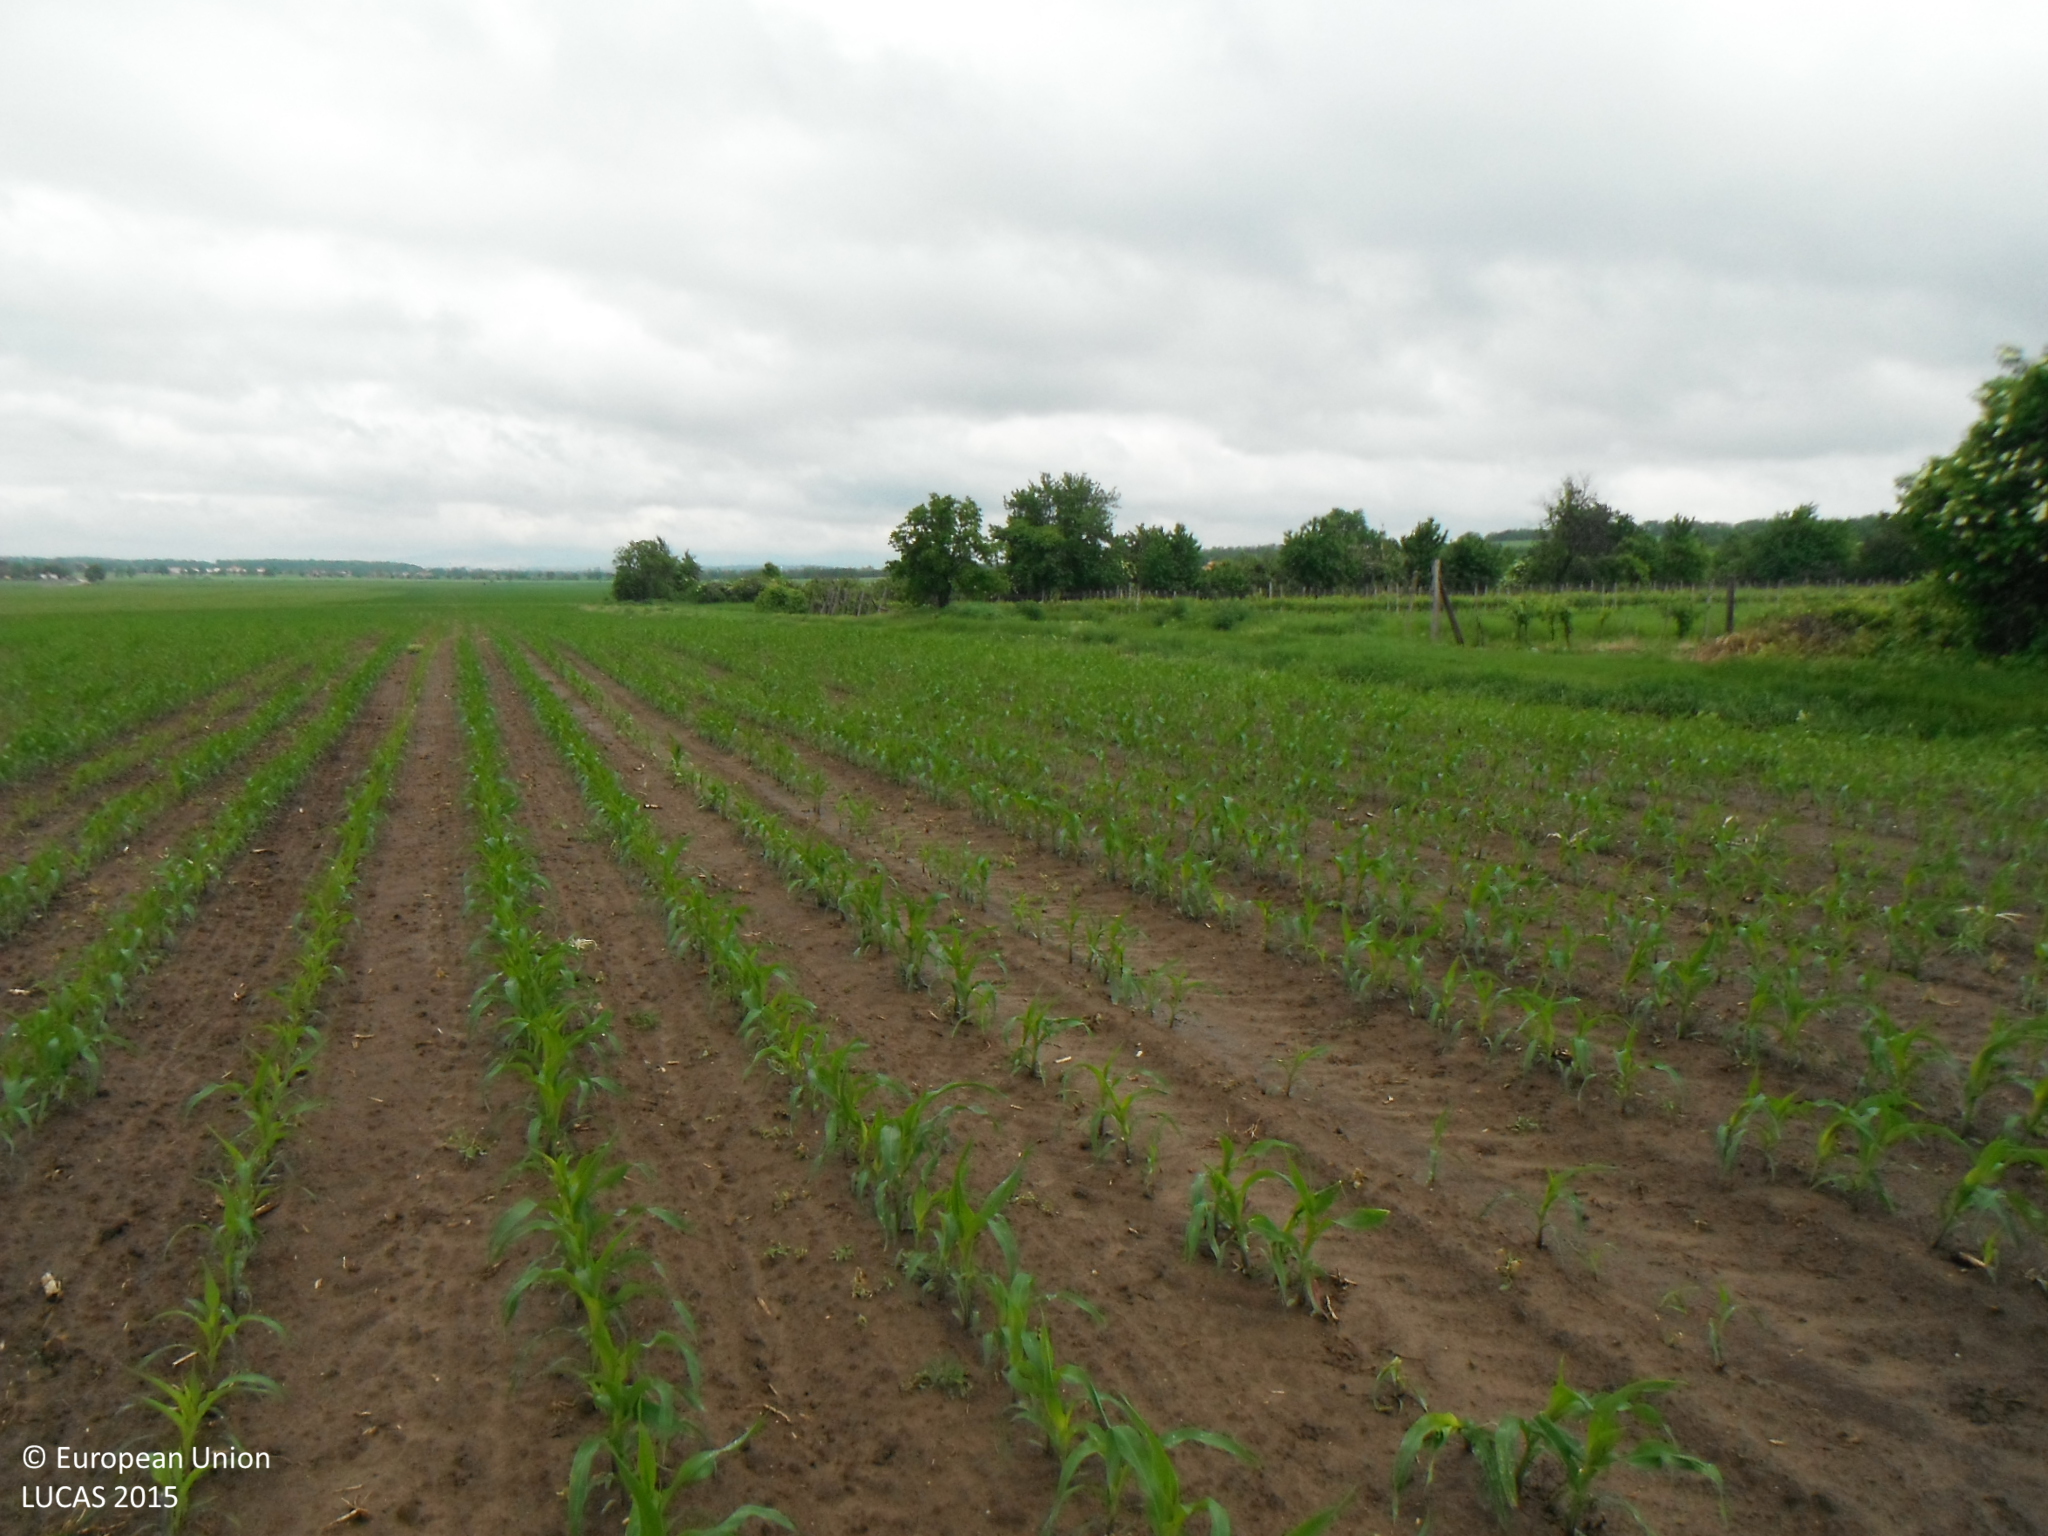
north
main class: Cropland
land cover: Maize
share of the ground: 25 - 50 %
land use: Agriculture (excluding fallow land and kitchen gardens)
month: May
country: SK
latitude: 48.1687
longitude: 18.2299
